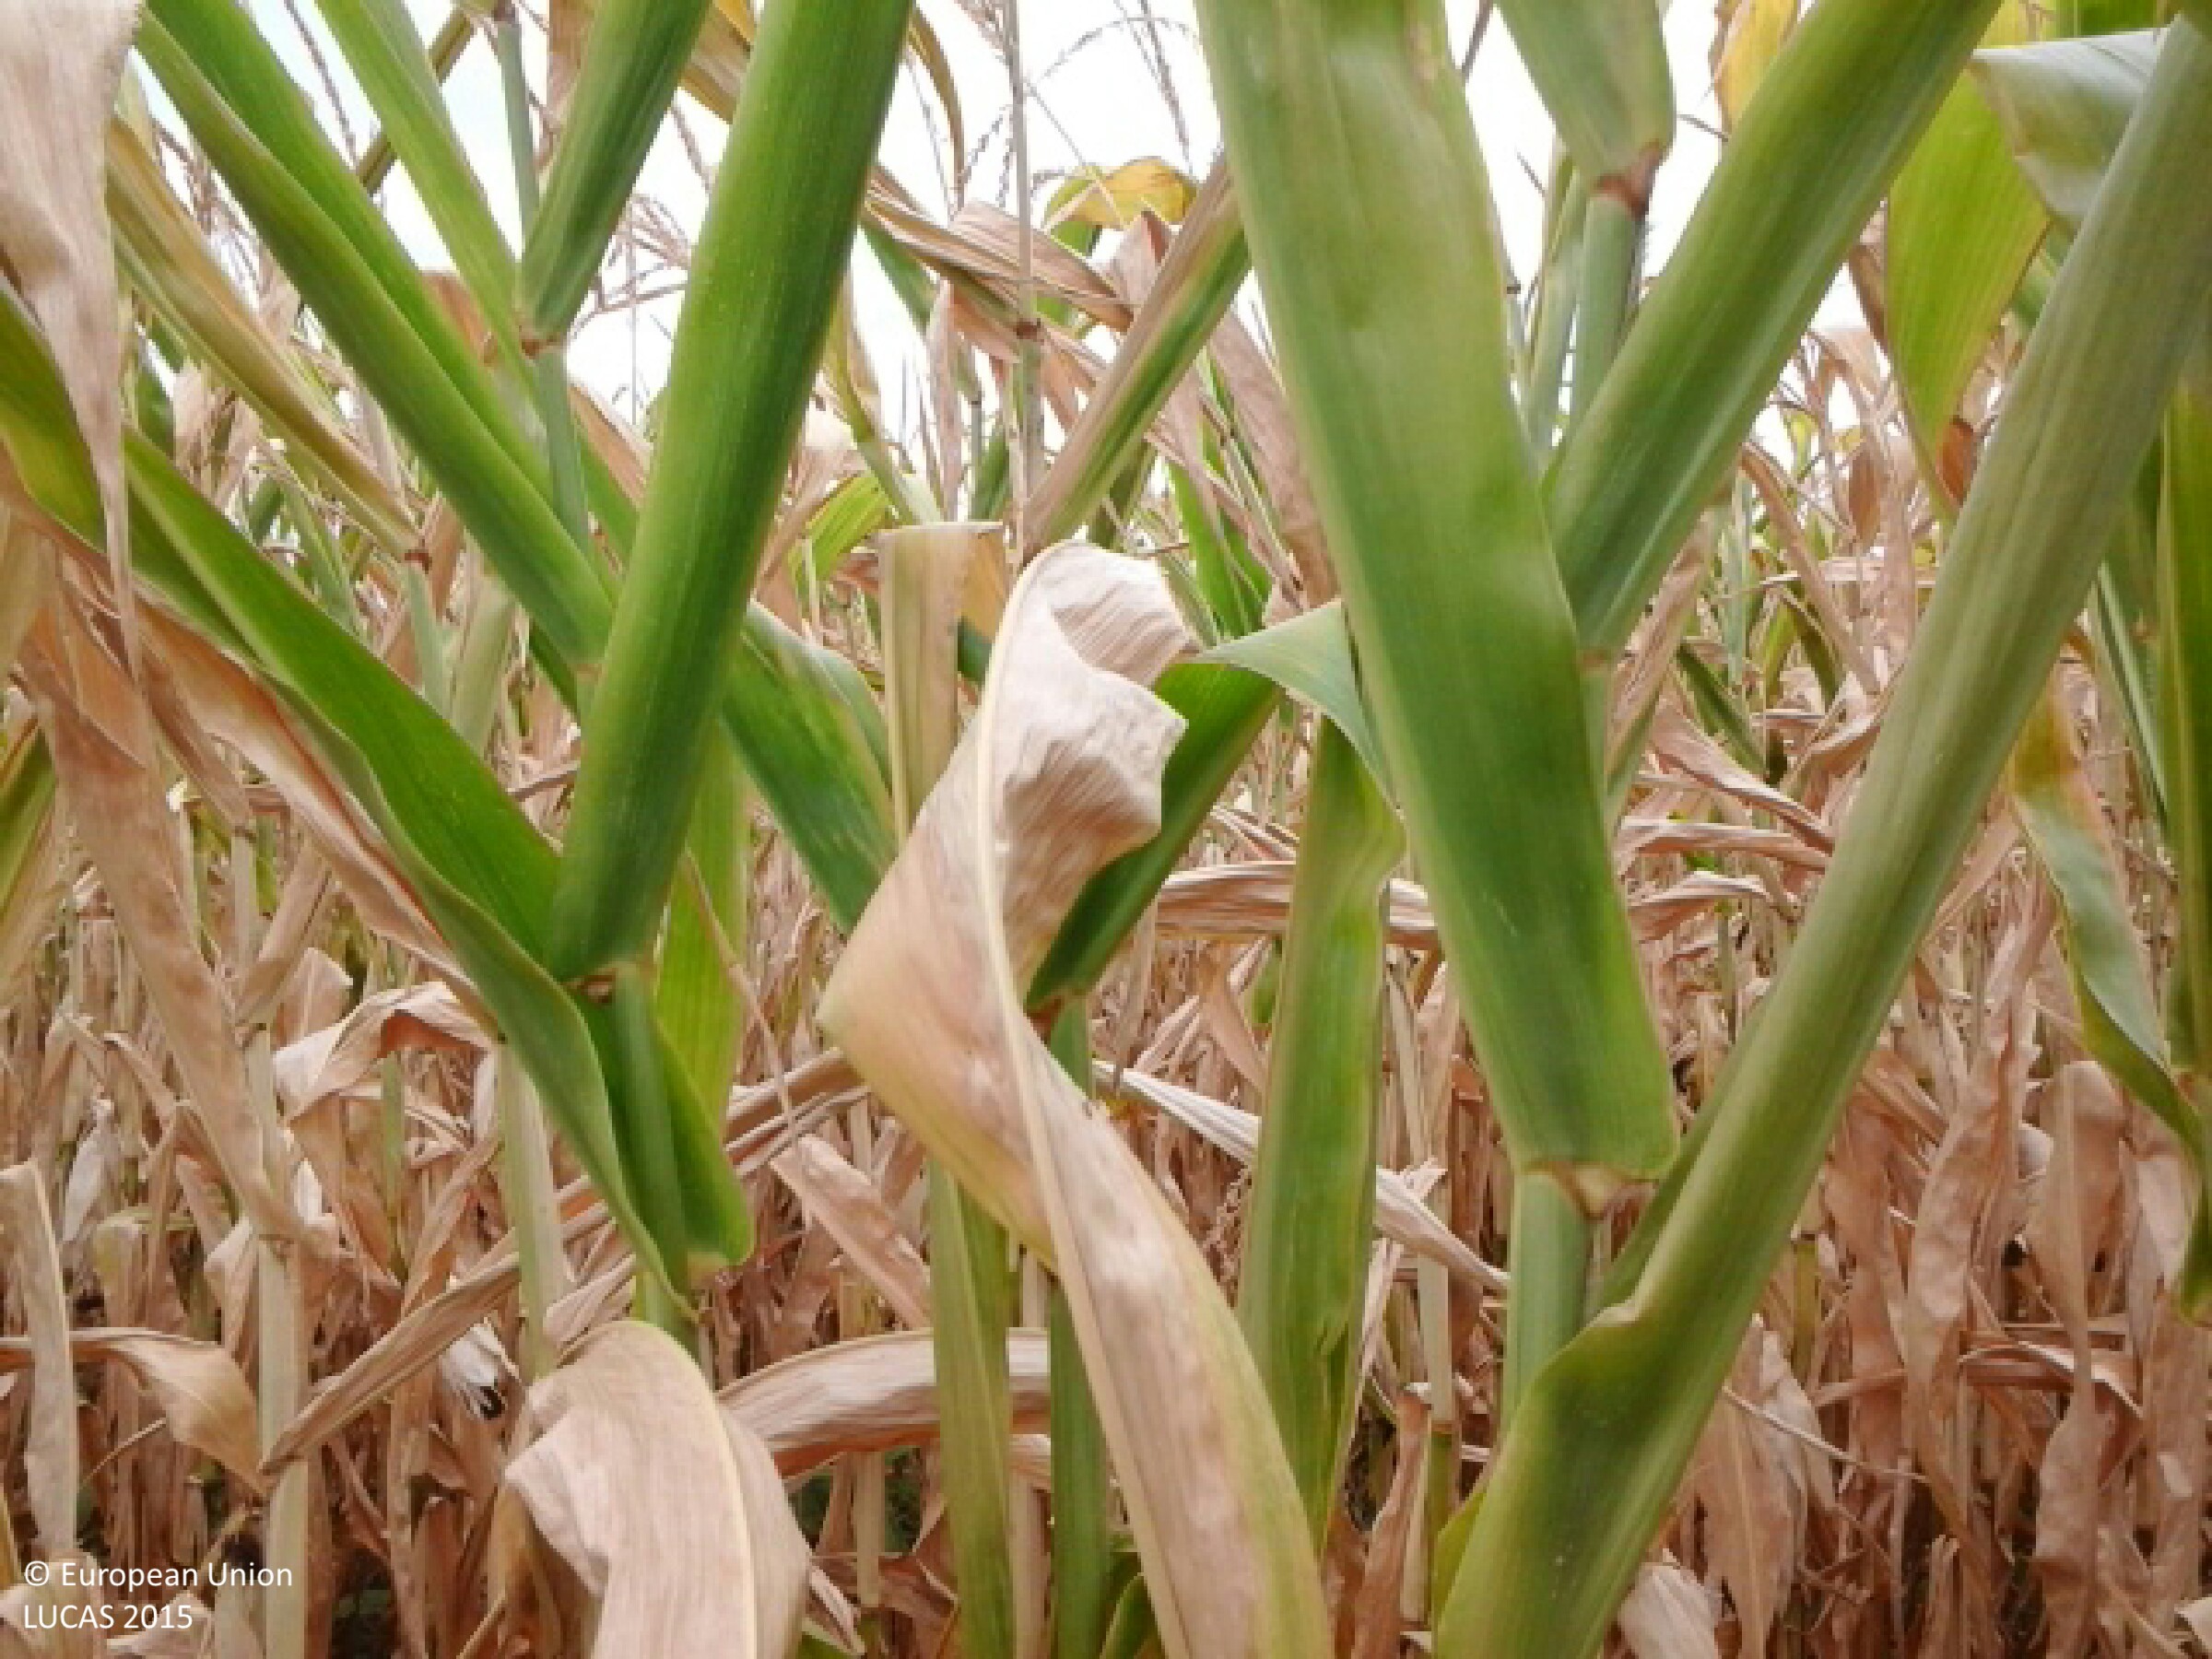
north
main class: Cropland
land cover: Maize
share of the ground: > 75 %
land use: Agriculture (excluding fallow land and kitchen gardens)
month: August
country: HU
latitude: 47.1747
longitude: 21.7477
